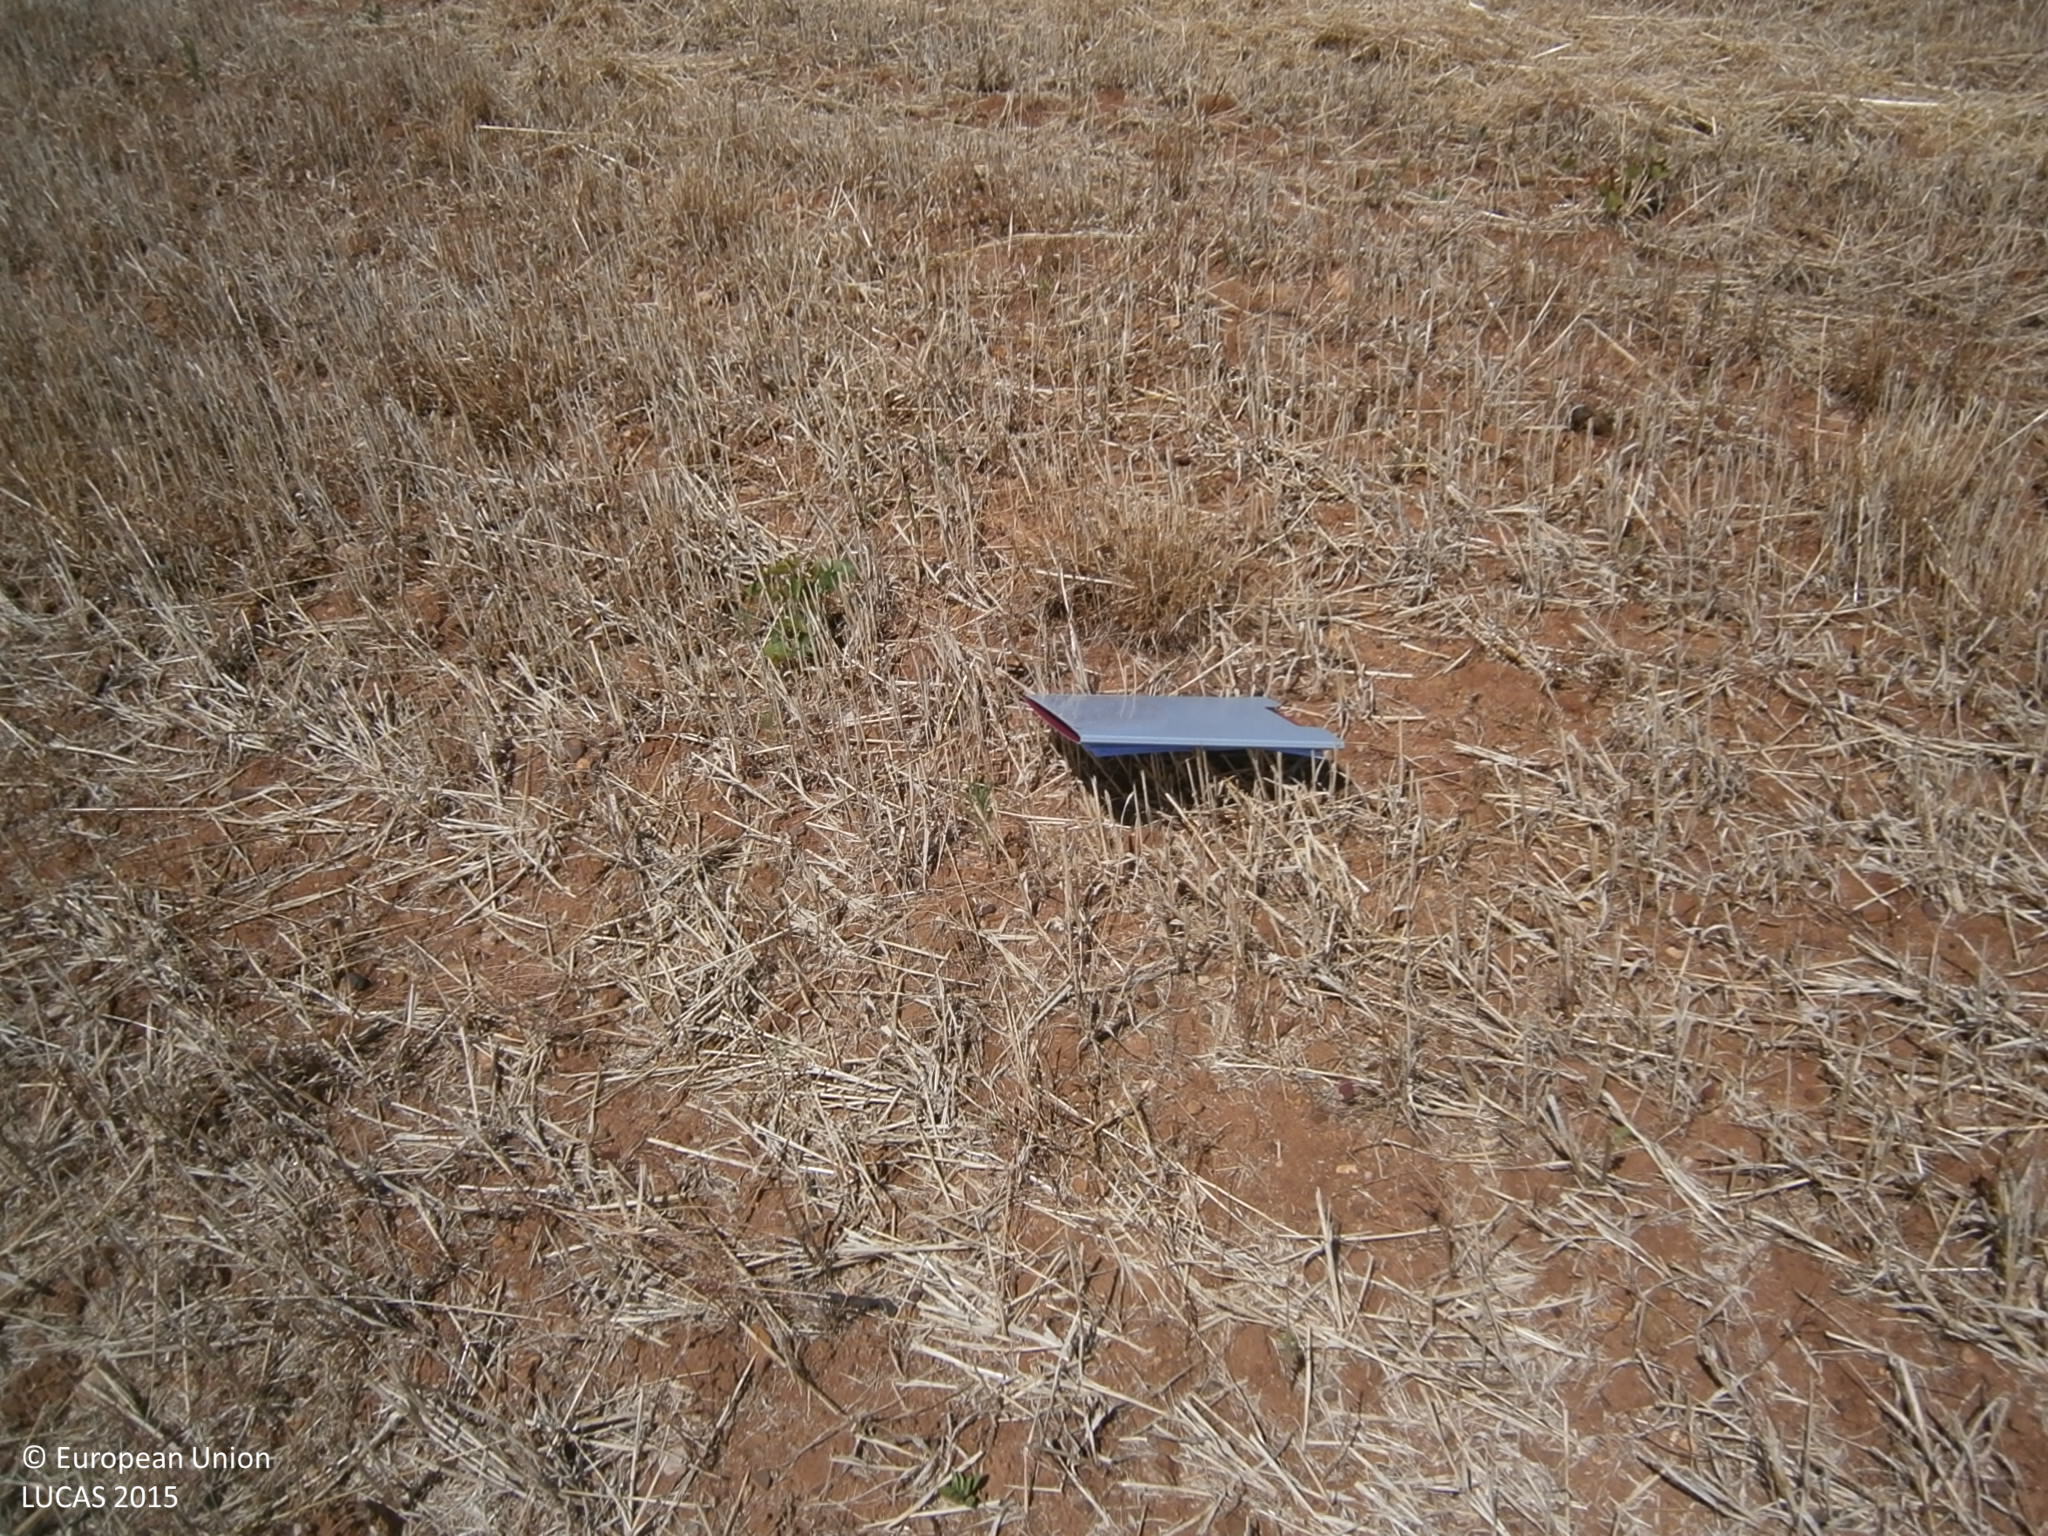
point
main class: Cropland
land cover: Oats
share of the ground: > 75 %
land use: Agriculture (excluding fallow land and kitchen gardens)
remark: Harvested field
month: June
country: ES
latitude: 38.7997
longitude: -6.4189
